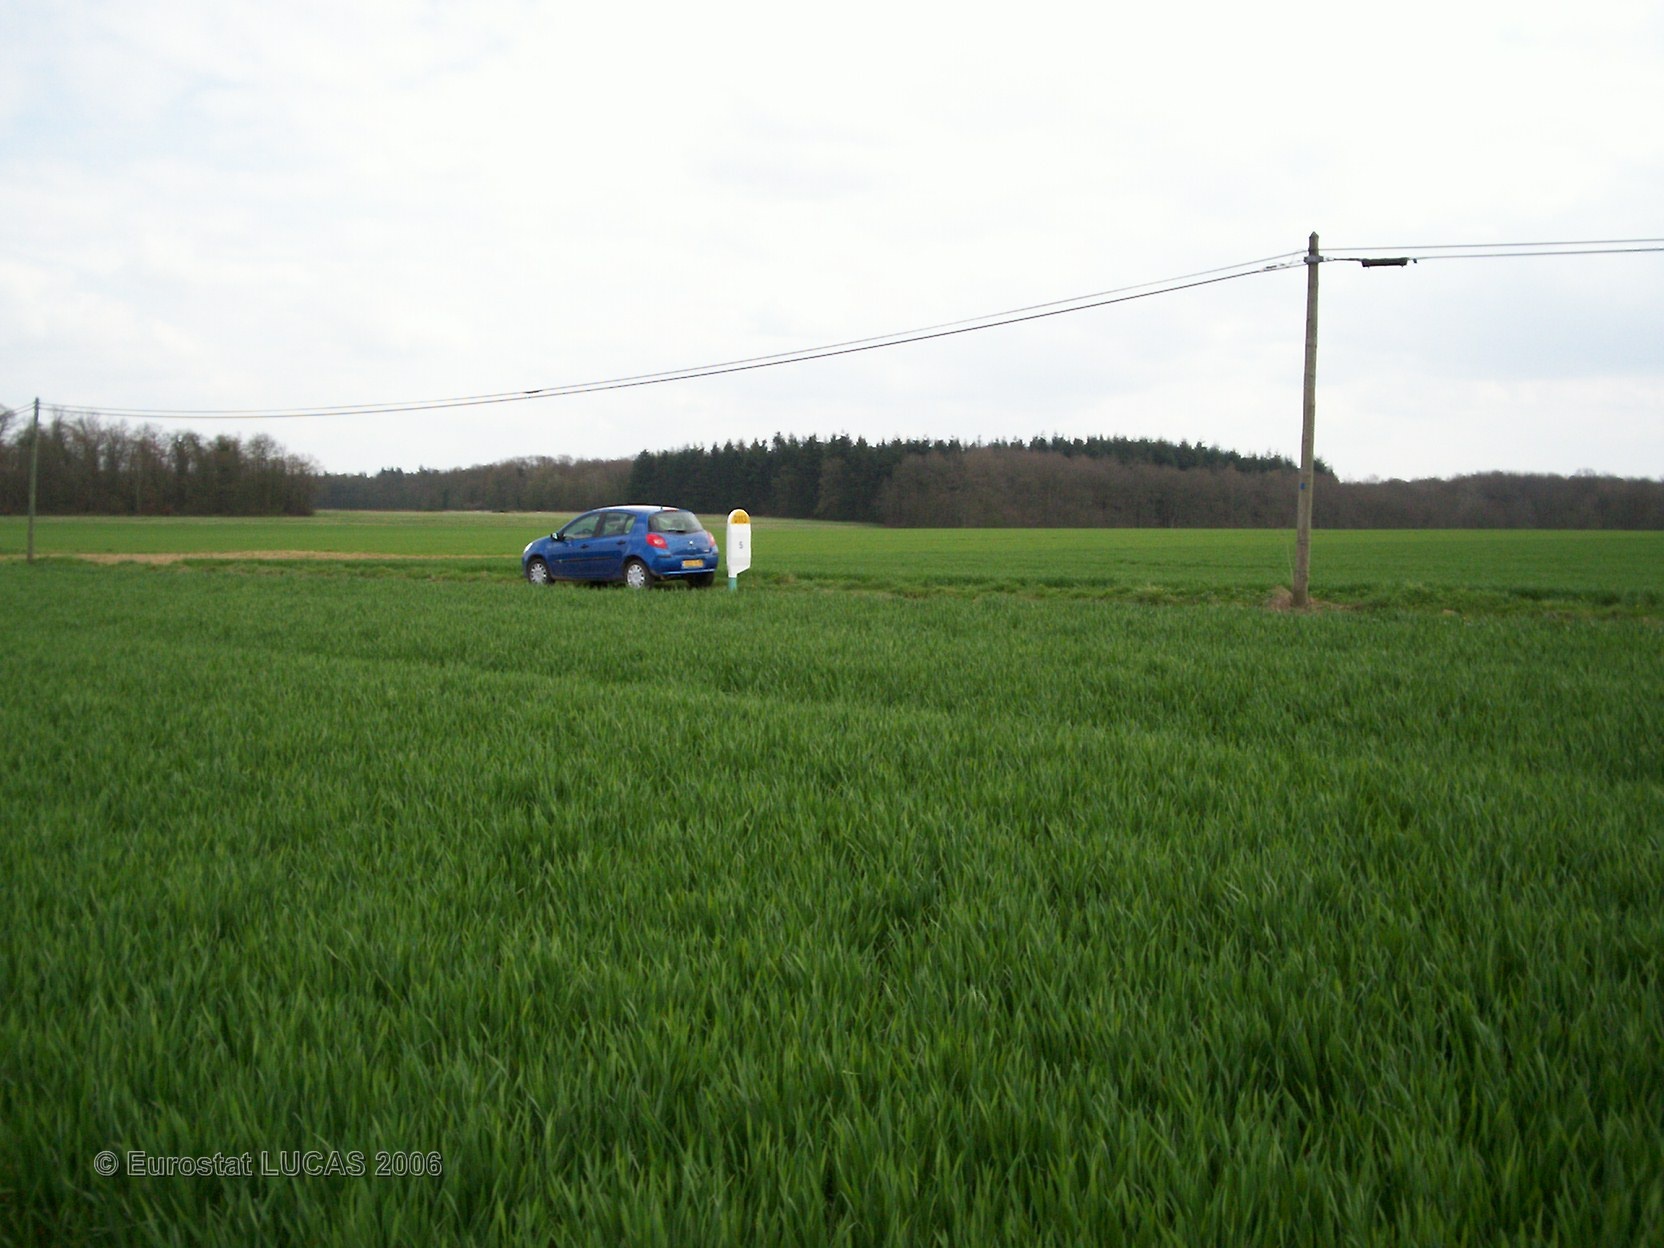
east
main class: Cropland
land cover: Common wheat
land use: Agriculture (excluding fallow land and kitchen gardens)
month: April
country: FR
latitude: 49.1244
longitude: 1.0303
